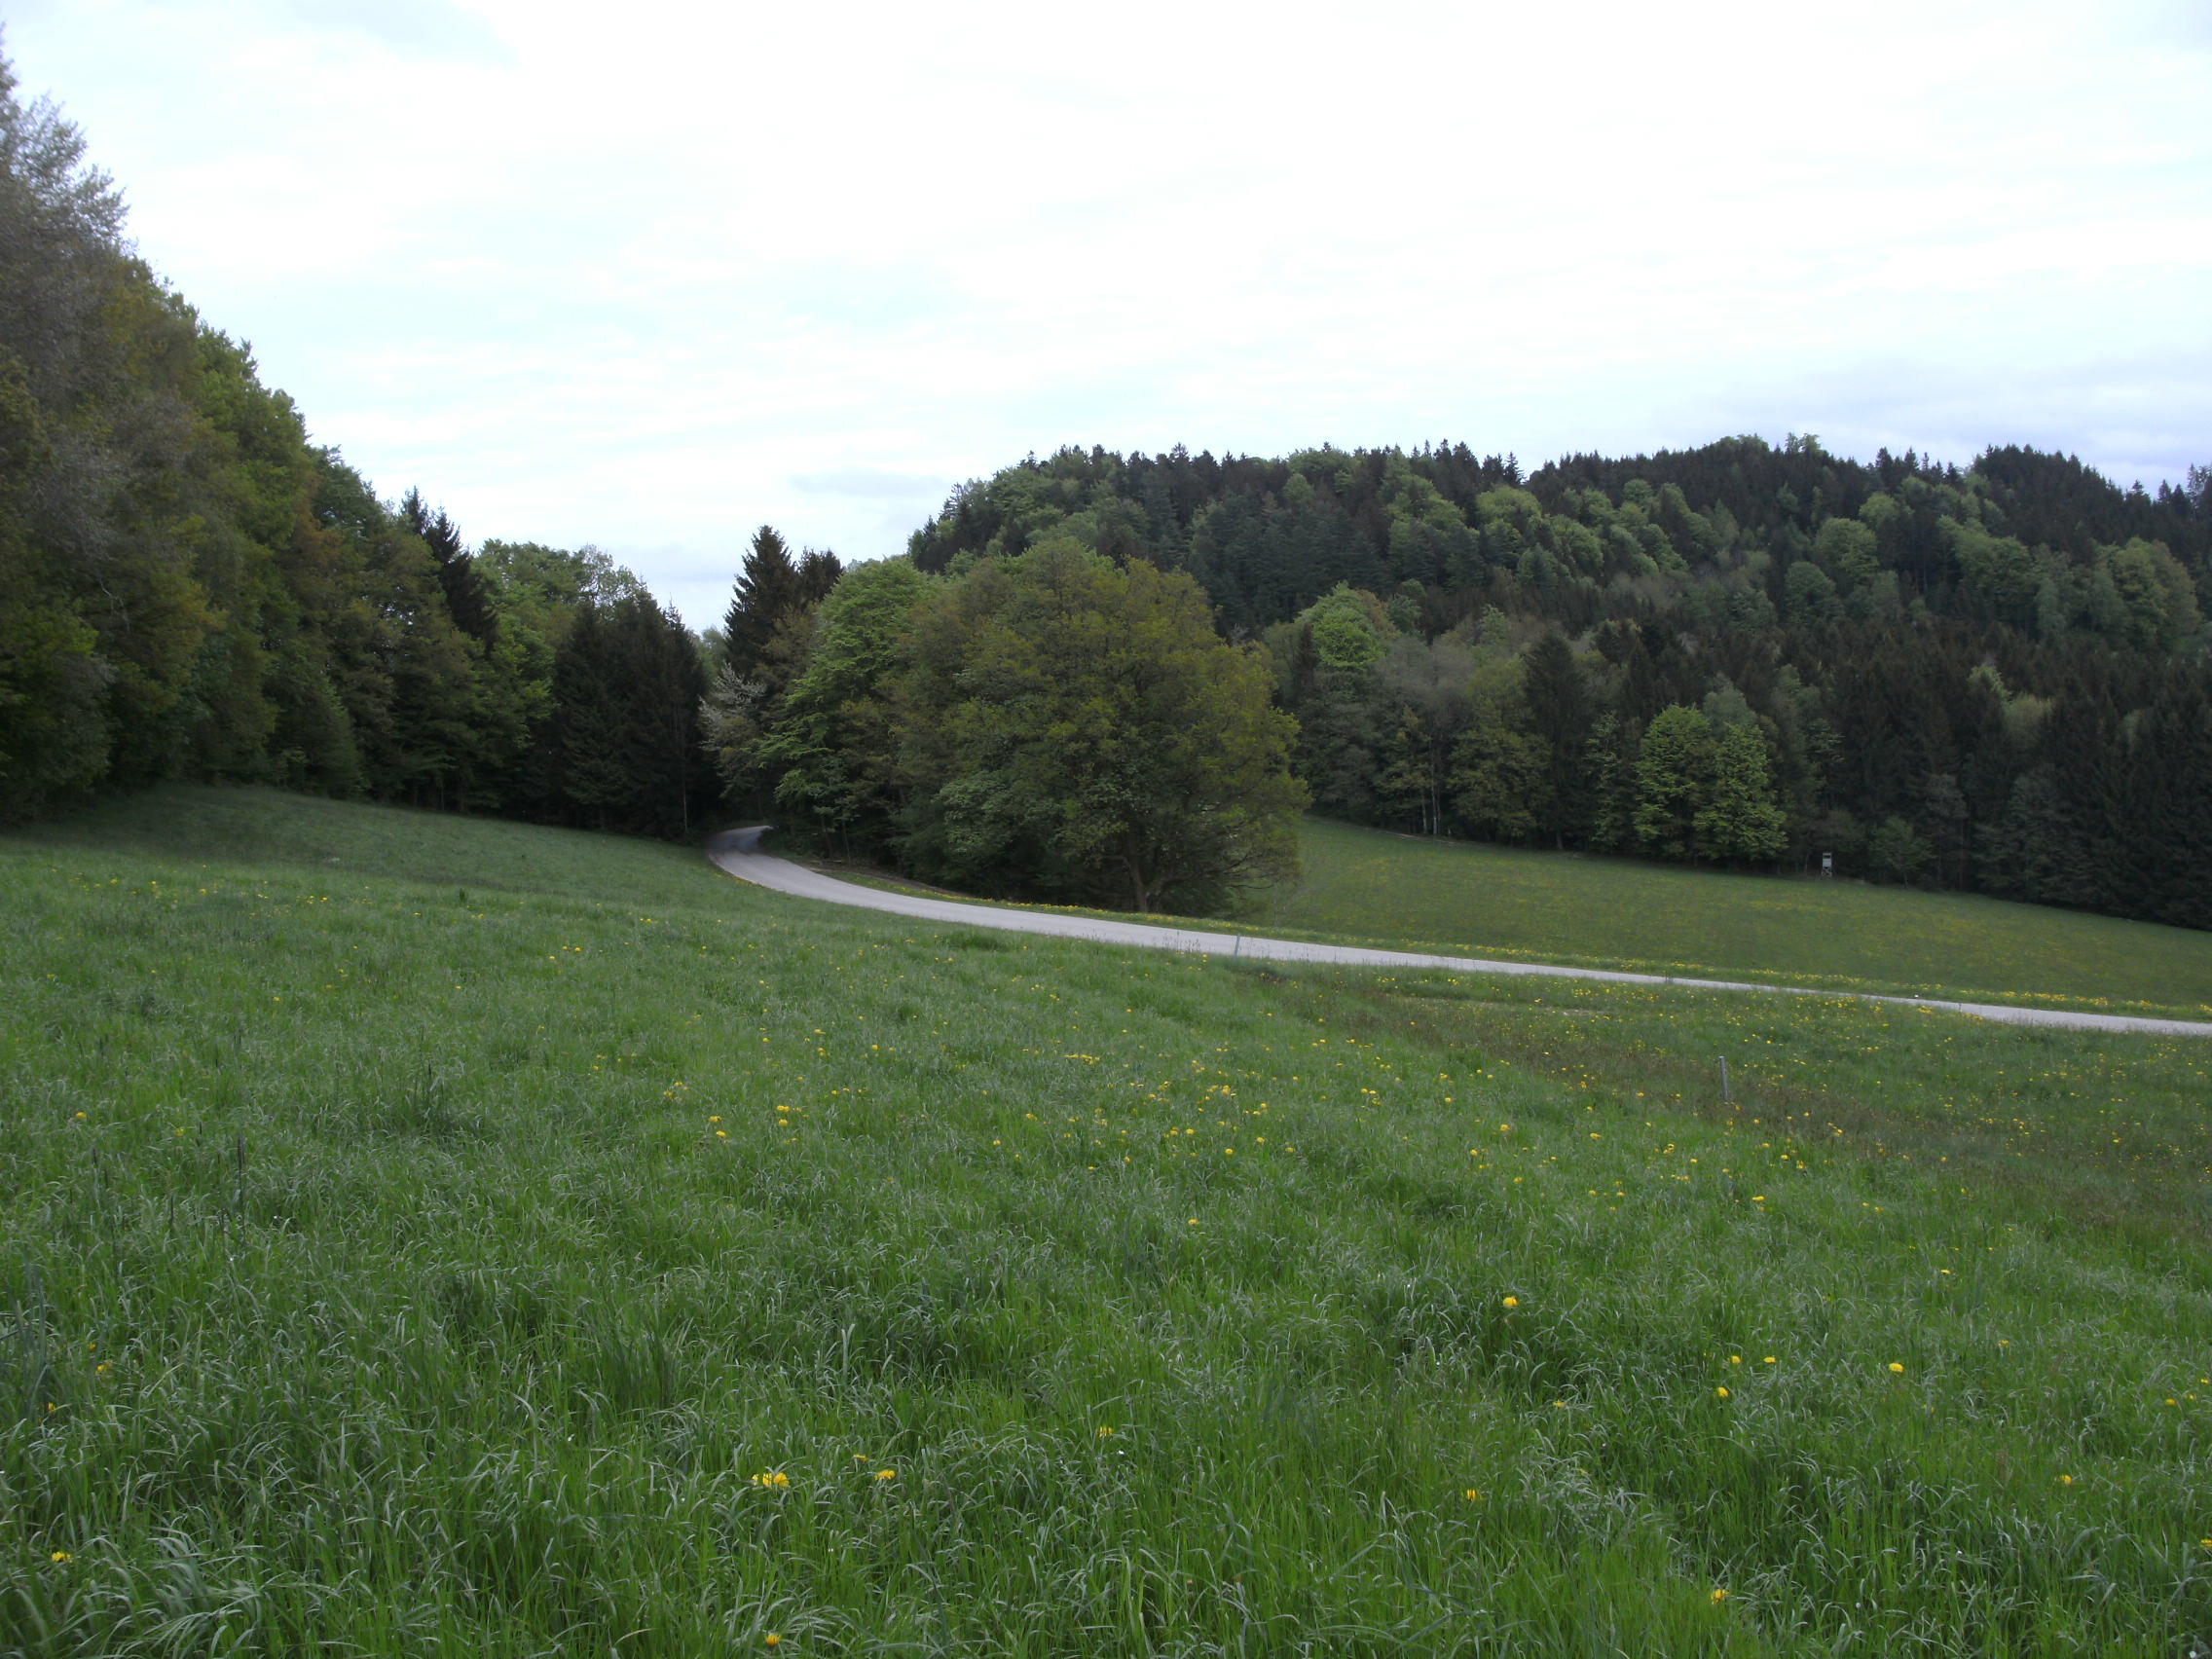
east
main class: Grassland
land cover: Grassland without tree/shrub cover
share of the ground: > 75 %
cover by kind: herbaceous plants 100 %
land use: Agriculture (excluding fallow land and kitchen gardens)
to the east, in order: Grassland without tree/shrub cover; Tracks; Grassland without tree/shrub cover; Paved roads, cycling and walking lanes; Grassland without tree/shrub cover; Tracks; Broadleaved woodland; Grassland without tree/shrub cover
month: May
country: AT
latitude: 48.1188
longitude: 13.3440
